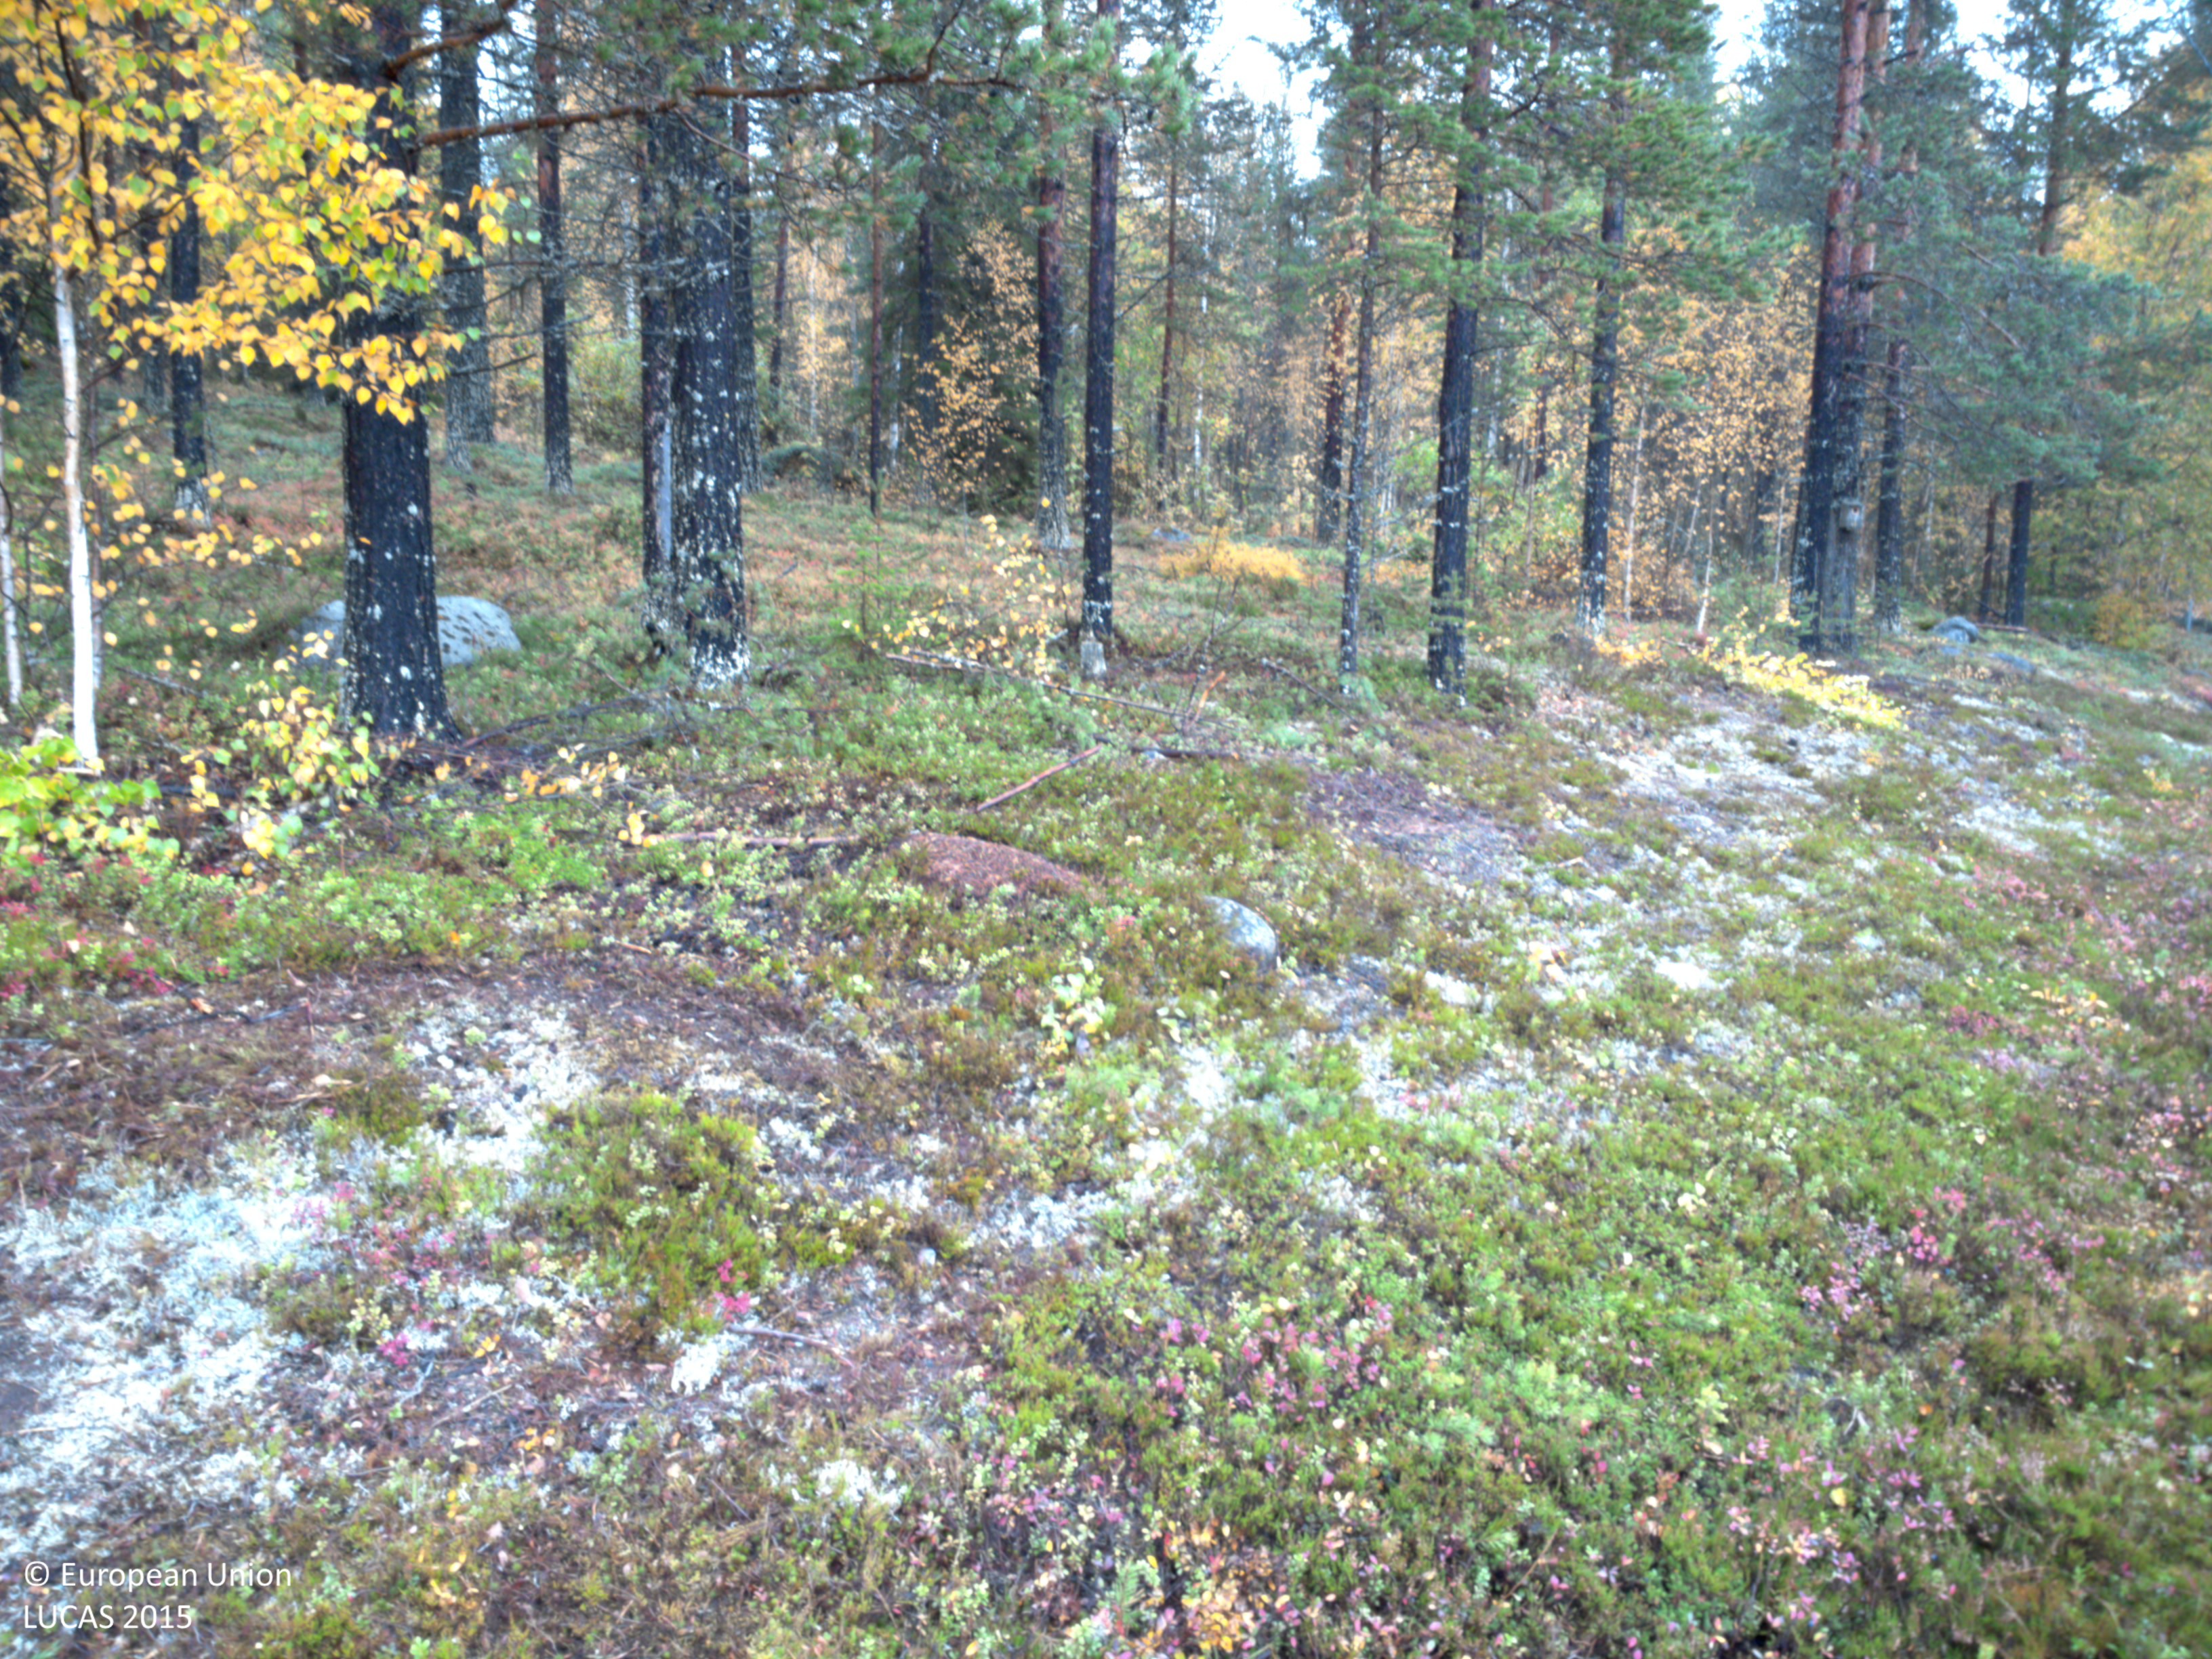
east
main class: Woodland
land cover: Pine dominated mixed woodland
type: boreal forest
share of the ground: > 75 %
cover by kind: coniferous forest trees 55 %, broadleaved forest trees 25 %, shrubs 10 %, herbaceous plants 5 %, lichens and mosses 5 %
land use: Forestry
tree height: > 5 m
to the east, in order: Ditches and canals; Pine dominated mixed woodland; Pine dominated coniferous woodland; Pine dominated mixed woodland; Pine dominated coniferous woodland
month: September
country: SE
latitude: 64.7168
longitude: 19.1387
